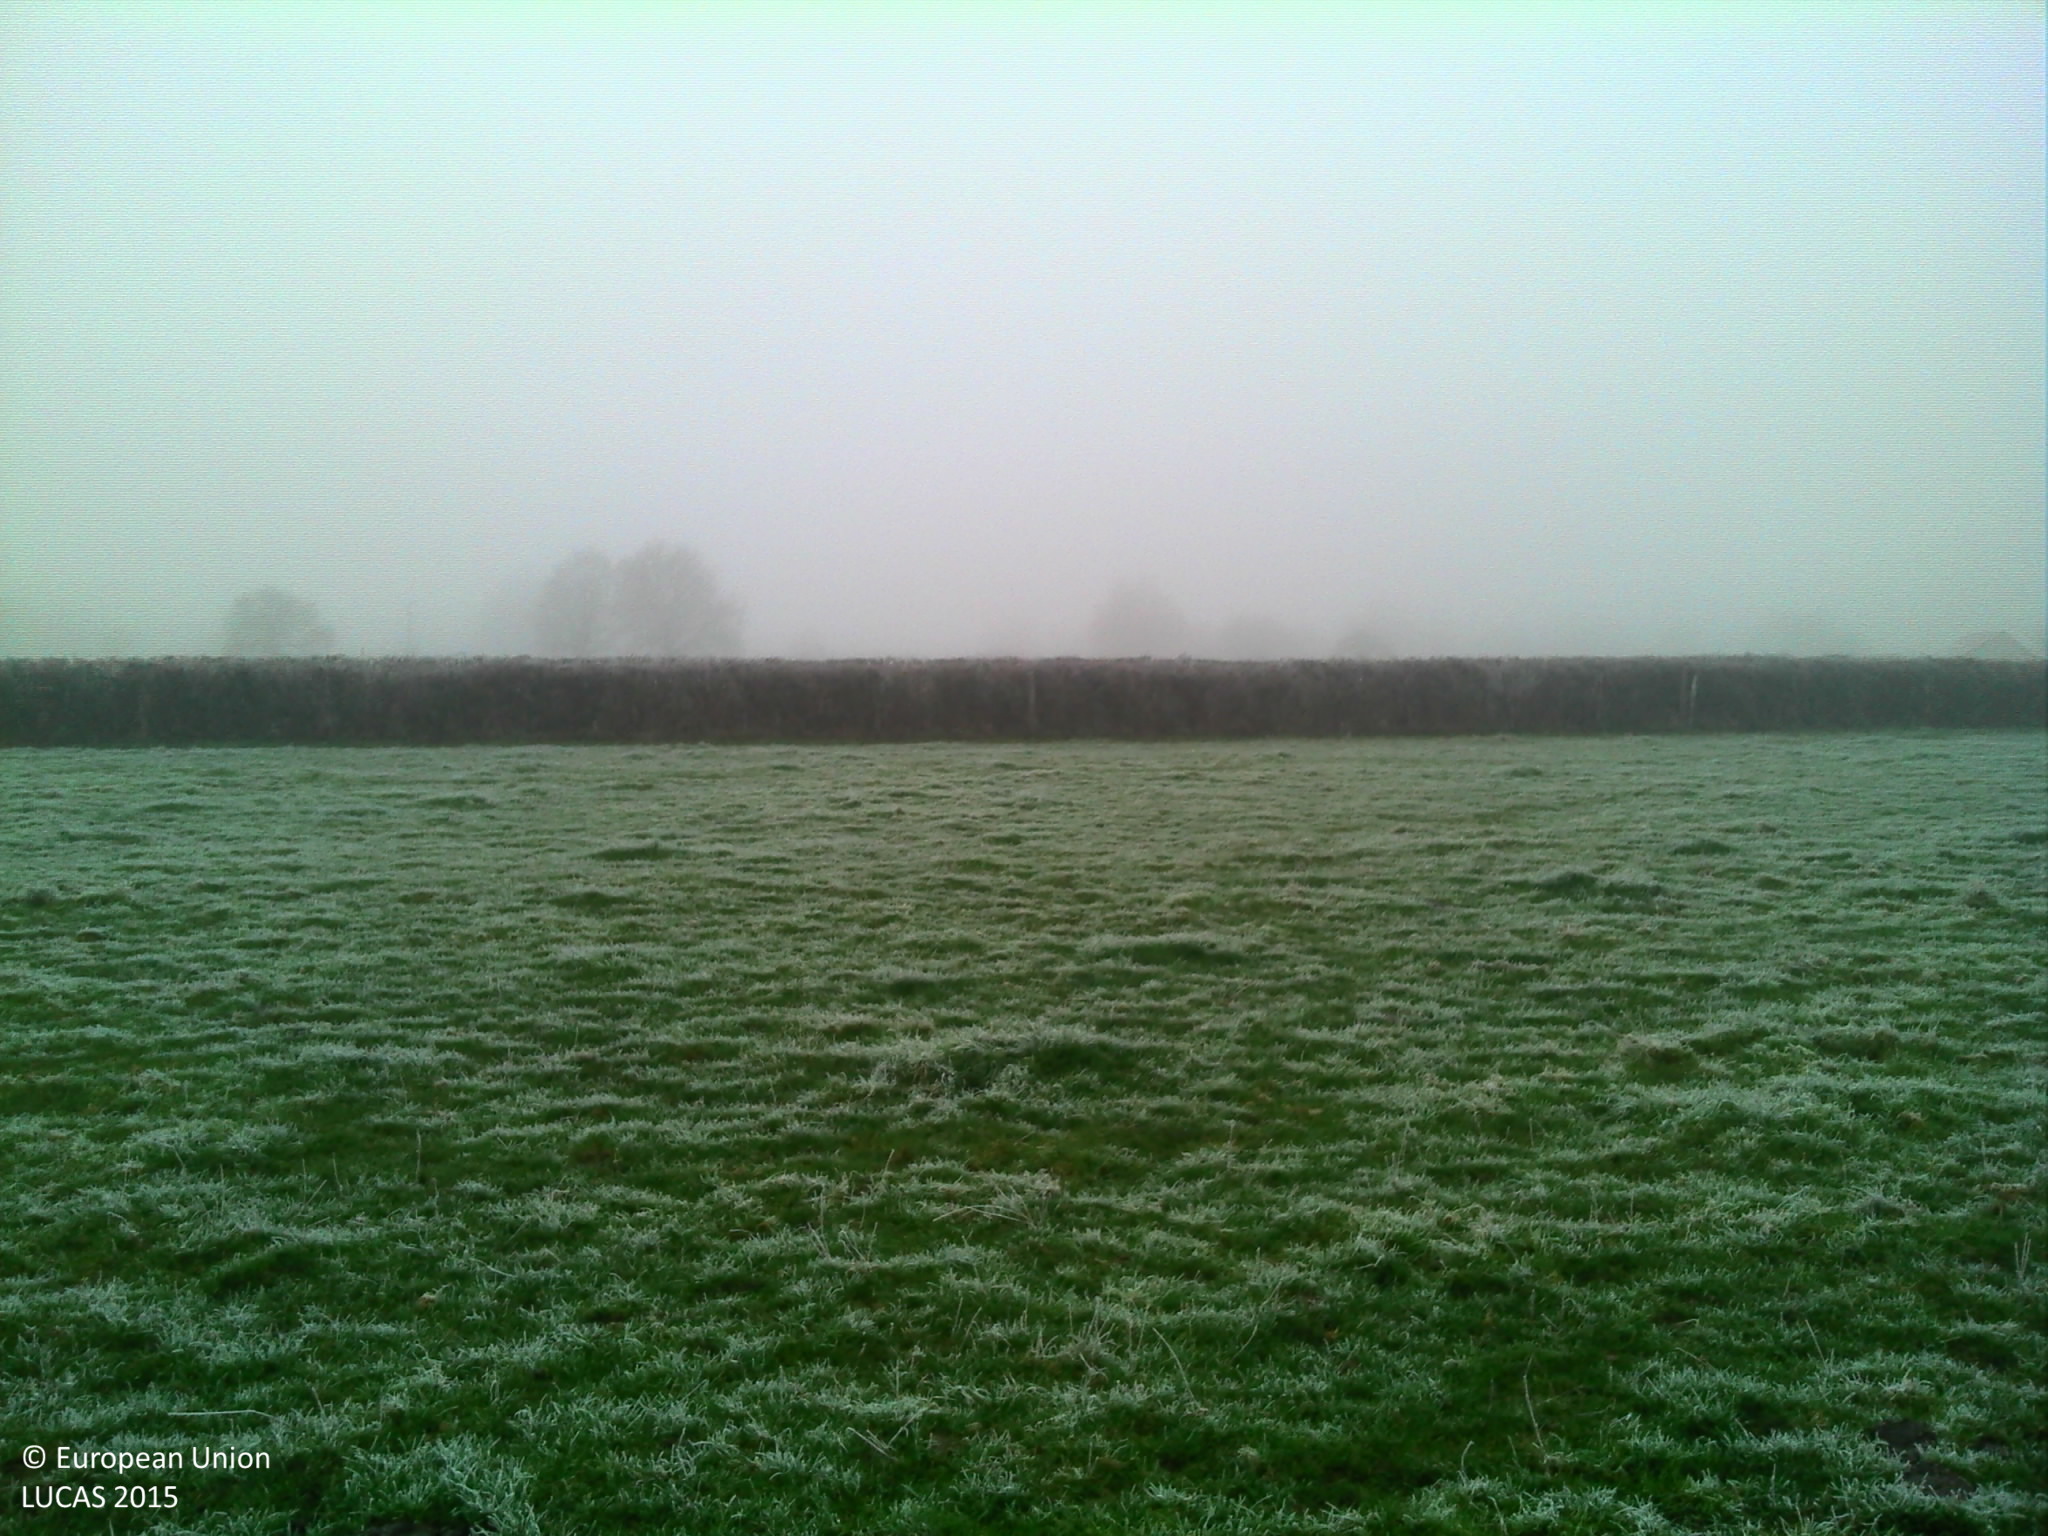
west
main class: Grassland
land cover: Grassland without tree/shrub cover
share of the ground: > 75 %
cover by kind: herbaceous plants 100 %
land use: Agriculture (excluding fallow land and kitchen gardens)
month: November
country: FR
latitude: 46.6135
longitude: 3.6400
